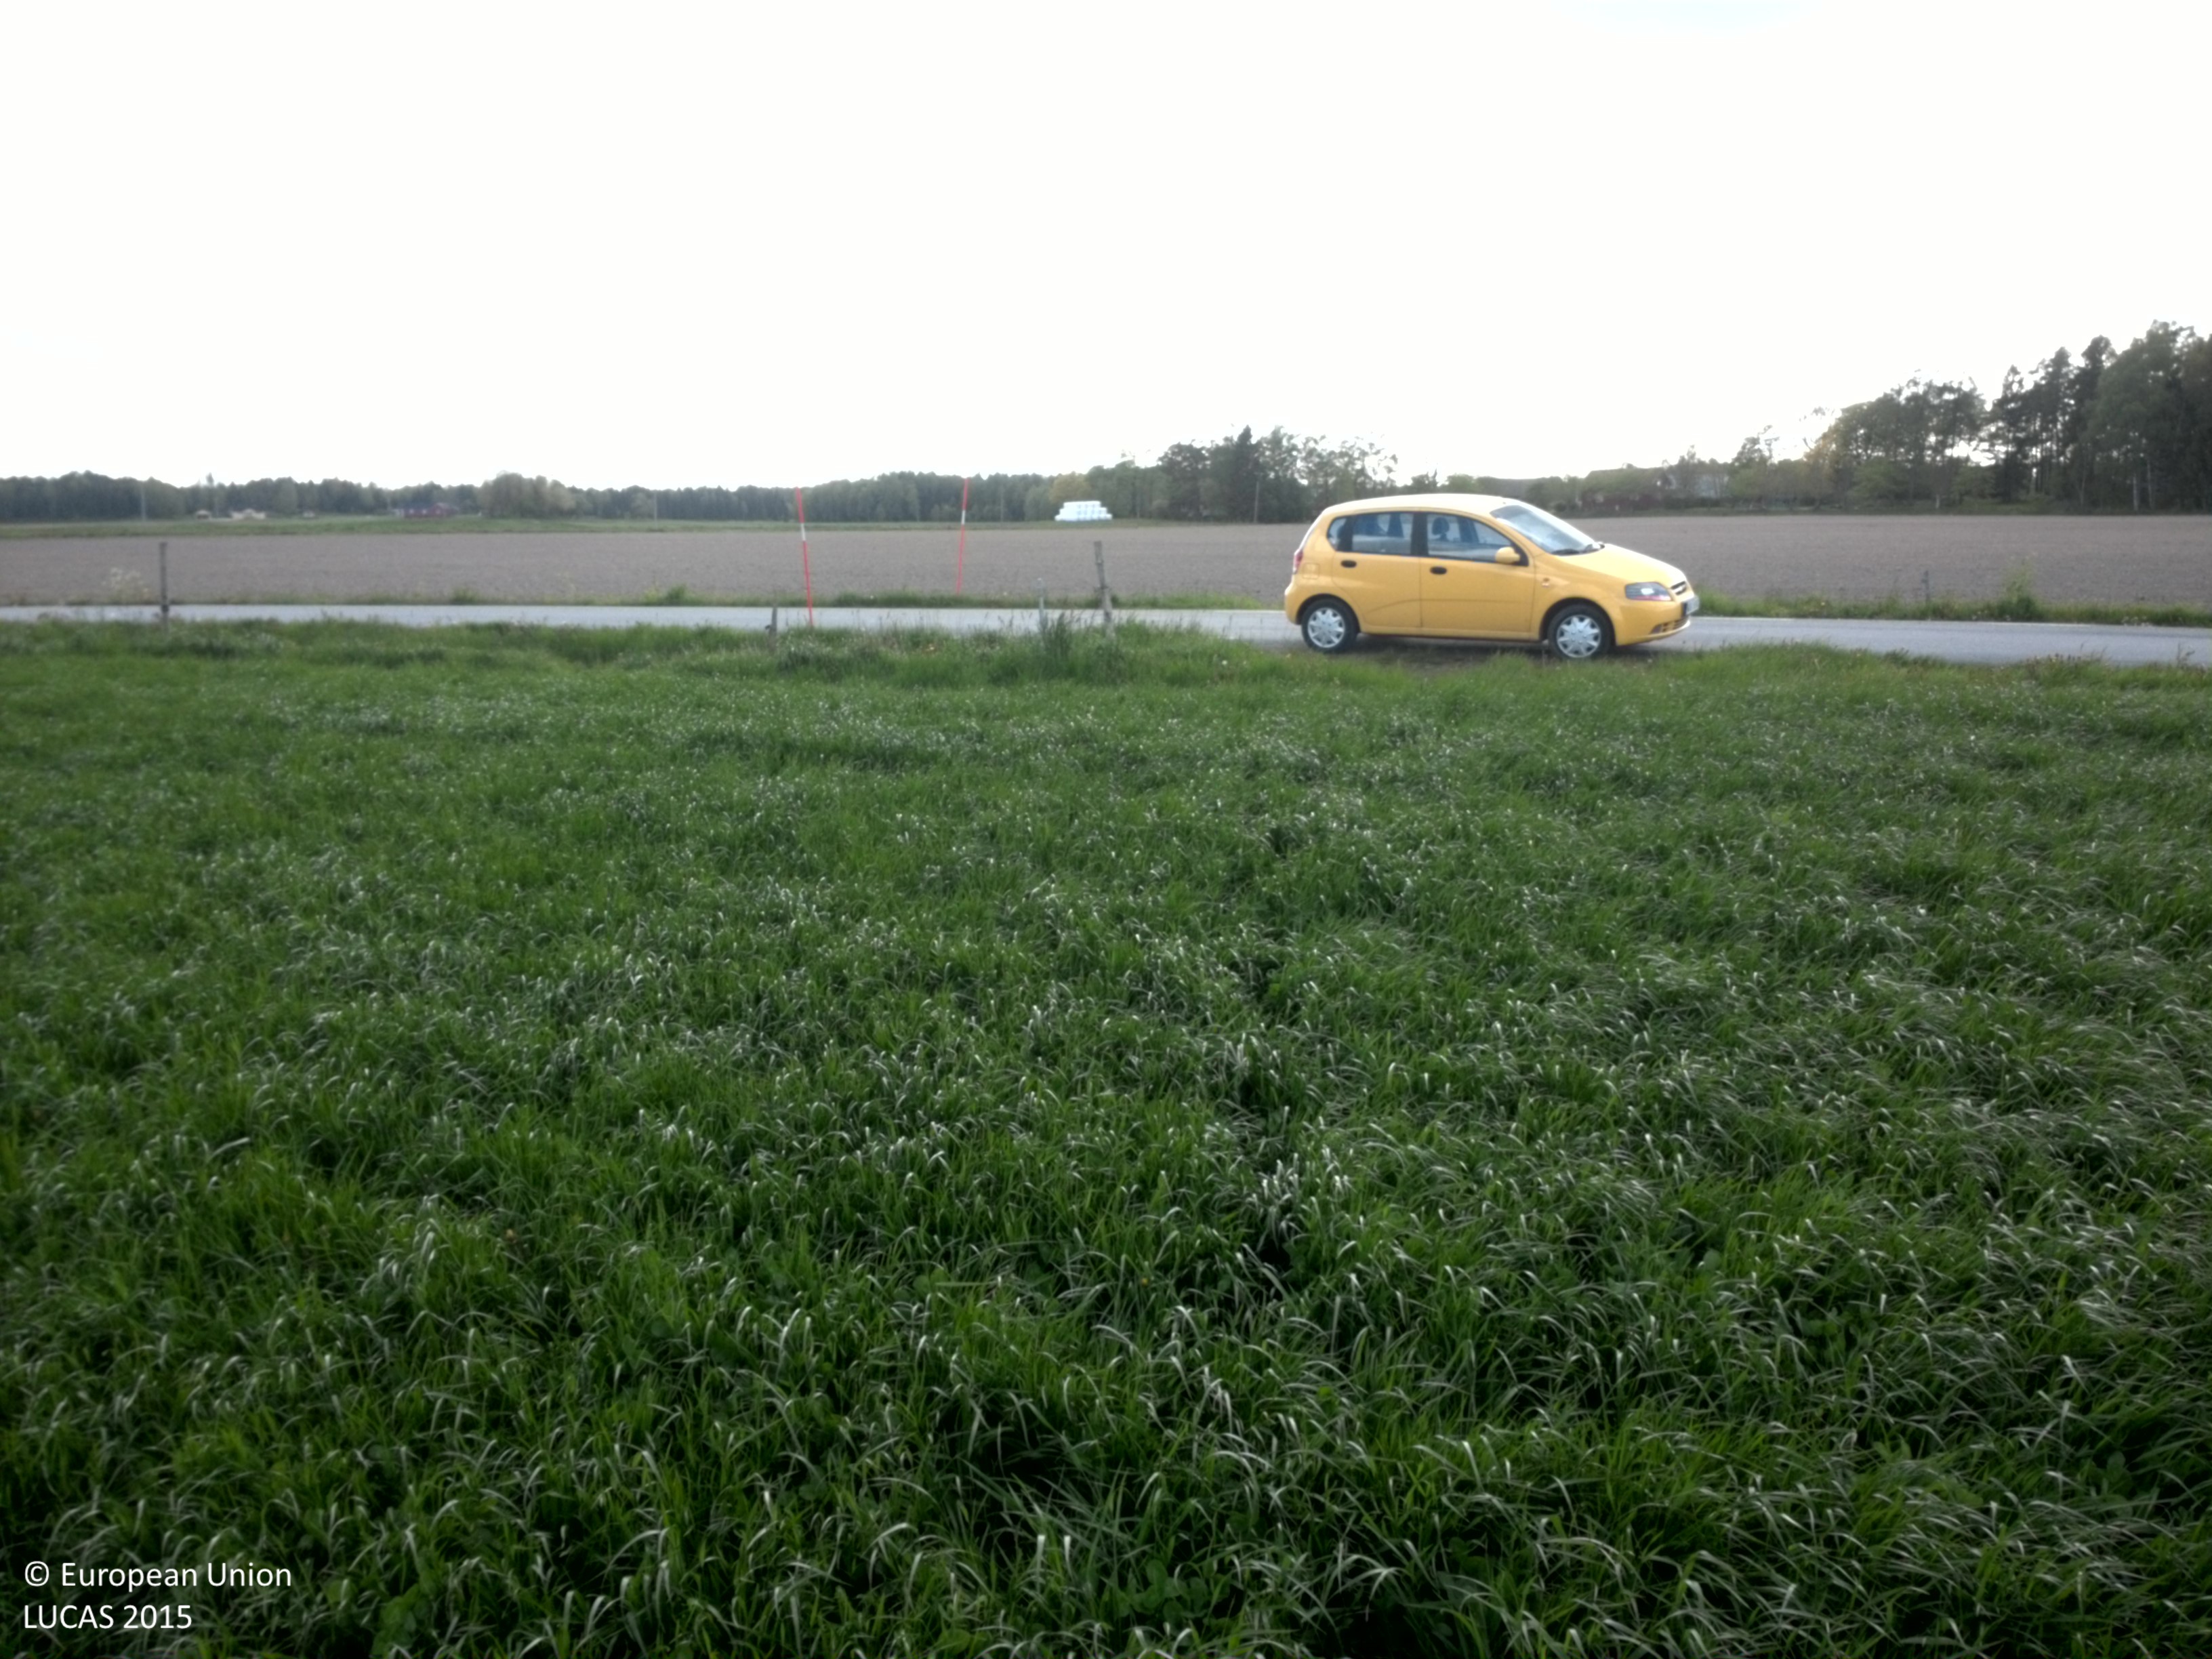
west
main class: Cropland
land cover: Temporary grasslands
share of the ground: > 75 %
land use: Agriculture (excluding fallow land and kitchen gardens)
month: May
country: SE
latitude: 58.4516
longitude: 12.3087
